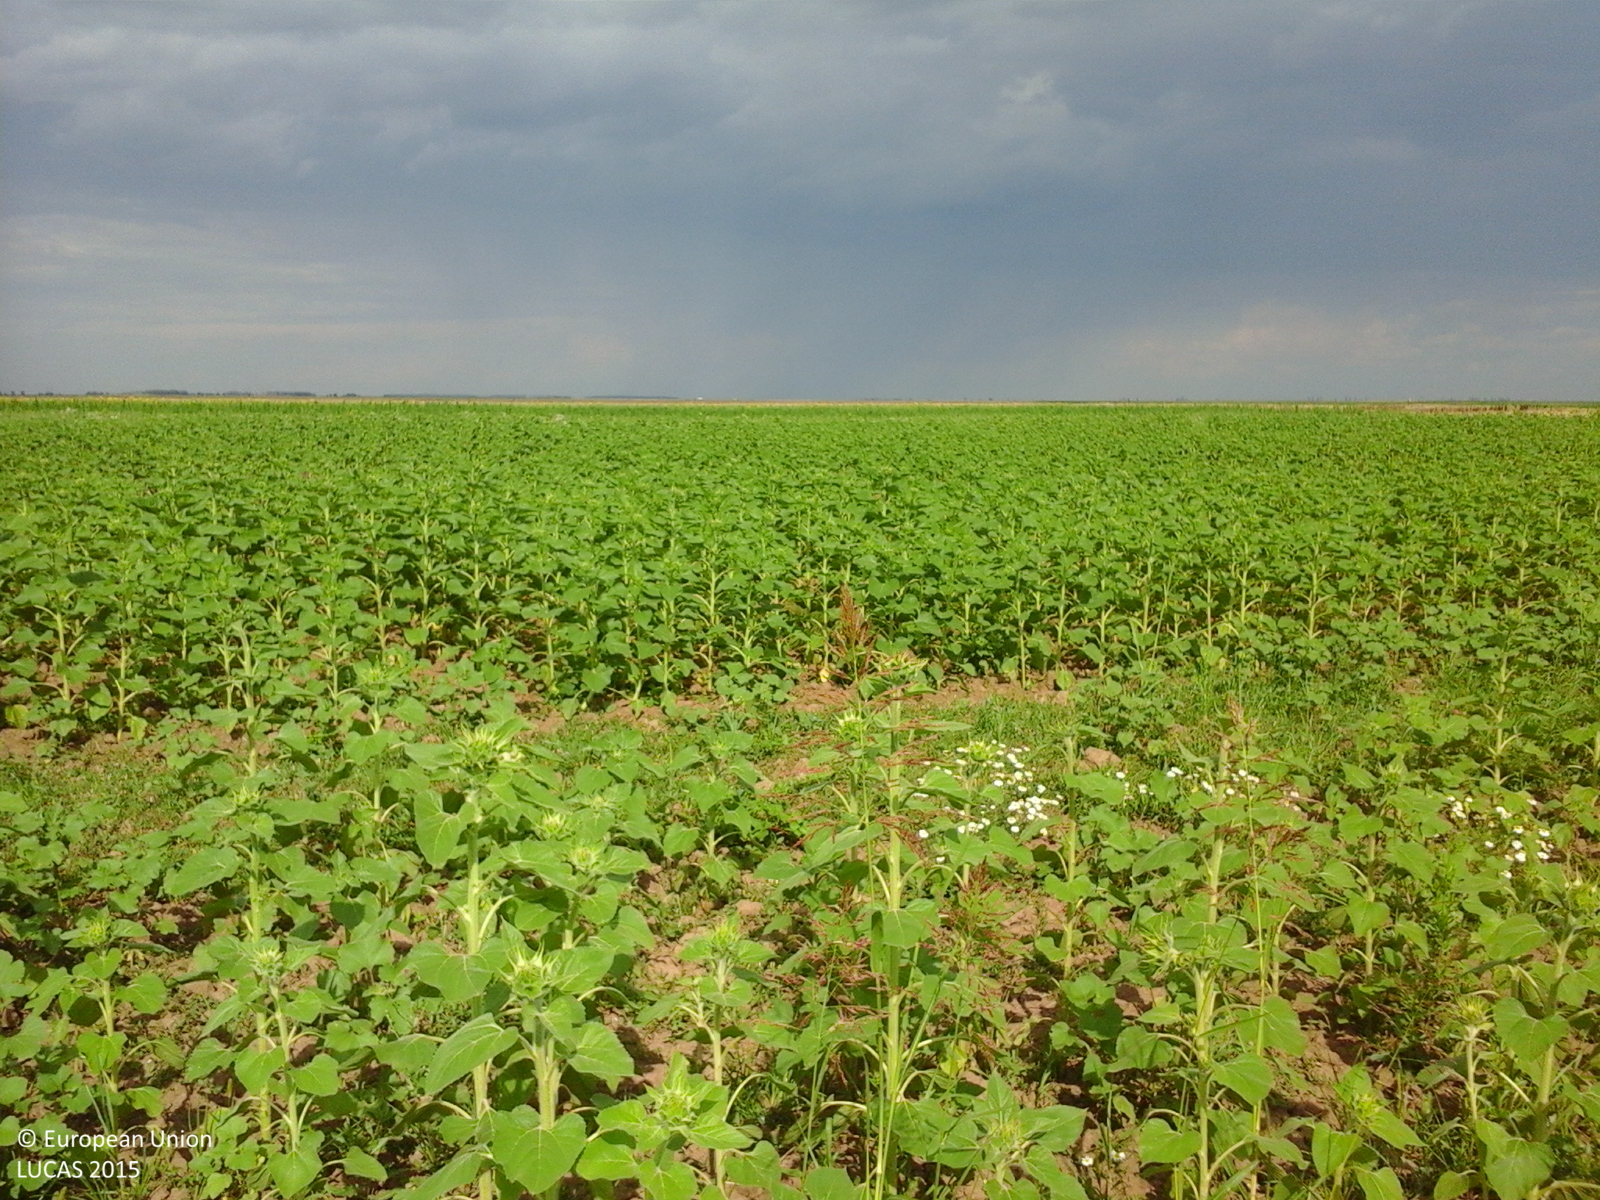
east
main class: Cropland
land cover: Sunflower
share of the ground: > 75 %
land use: Agriculture (excluding fallow land and kitchen gardens)
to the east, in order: Sunflower; Maize; Sunflower; Grassland without tree/shrub cover
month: July
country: RO
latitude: 44.2252
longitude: 25.1153
